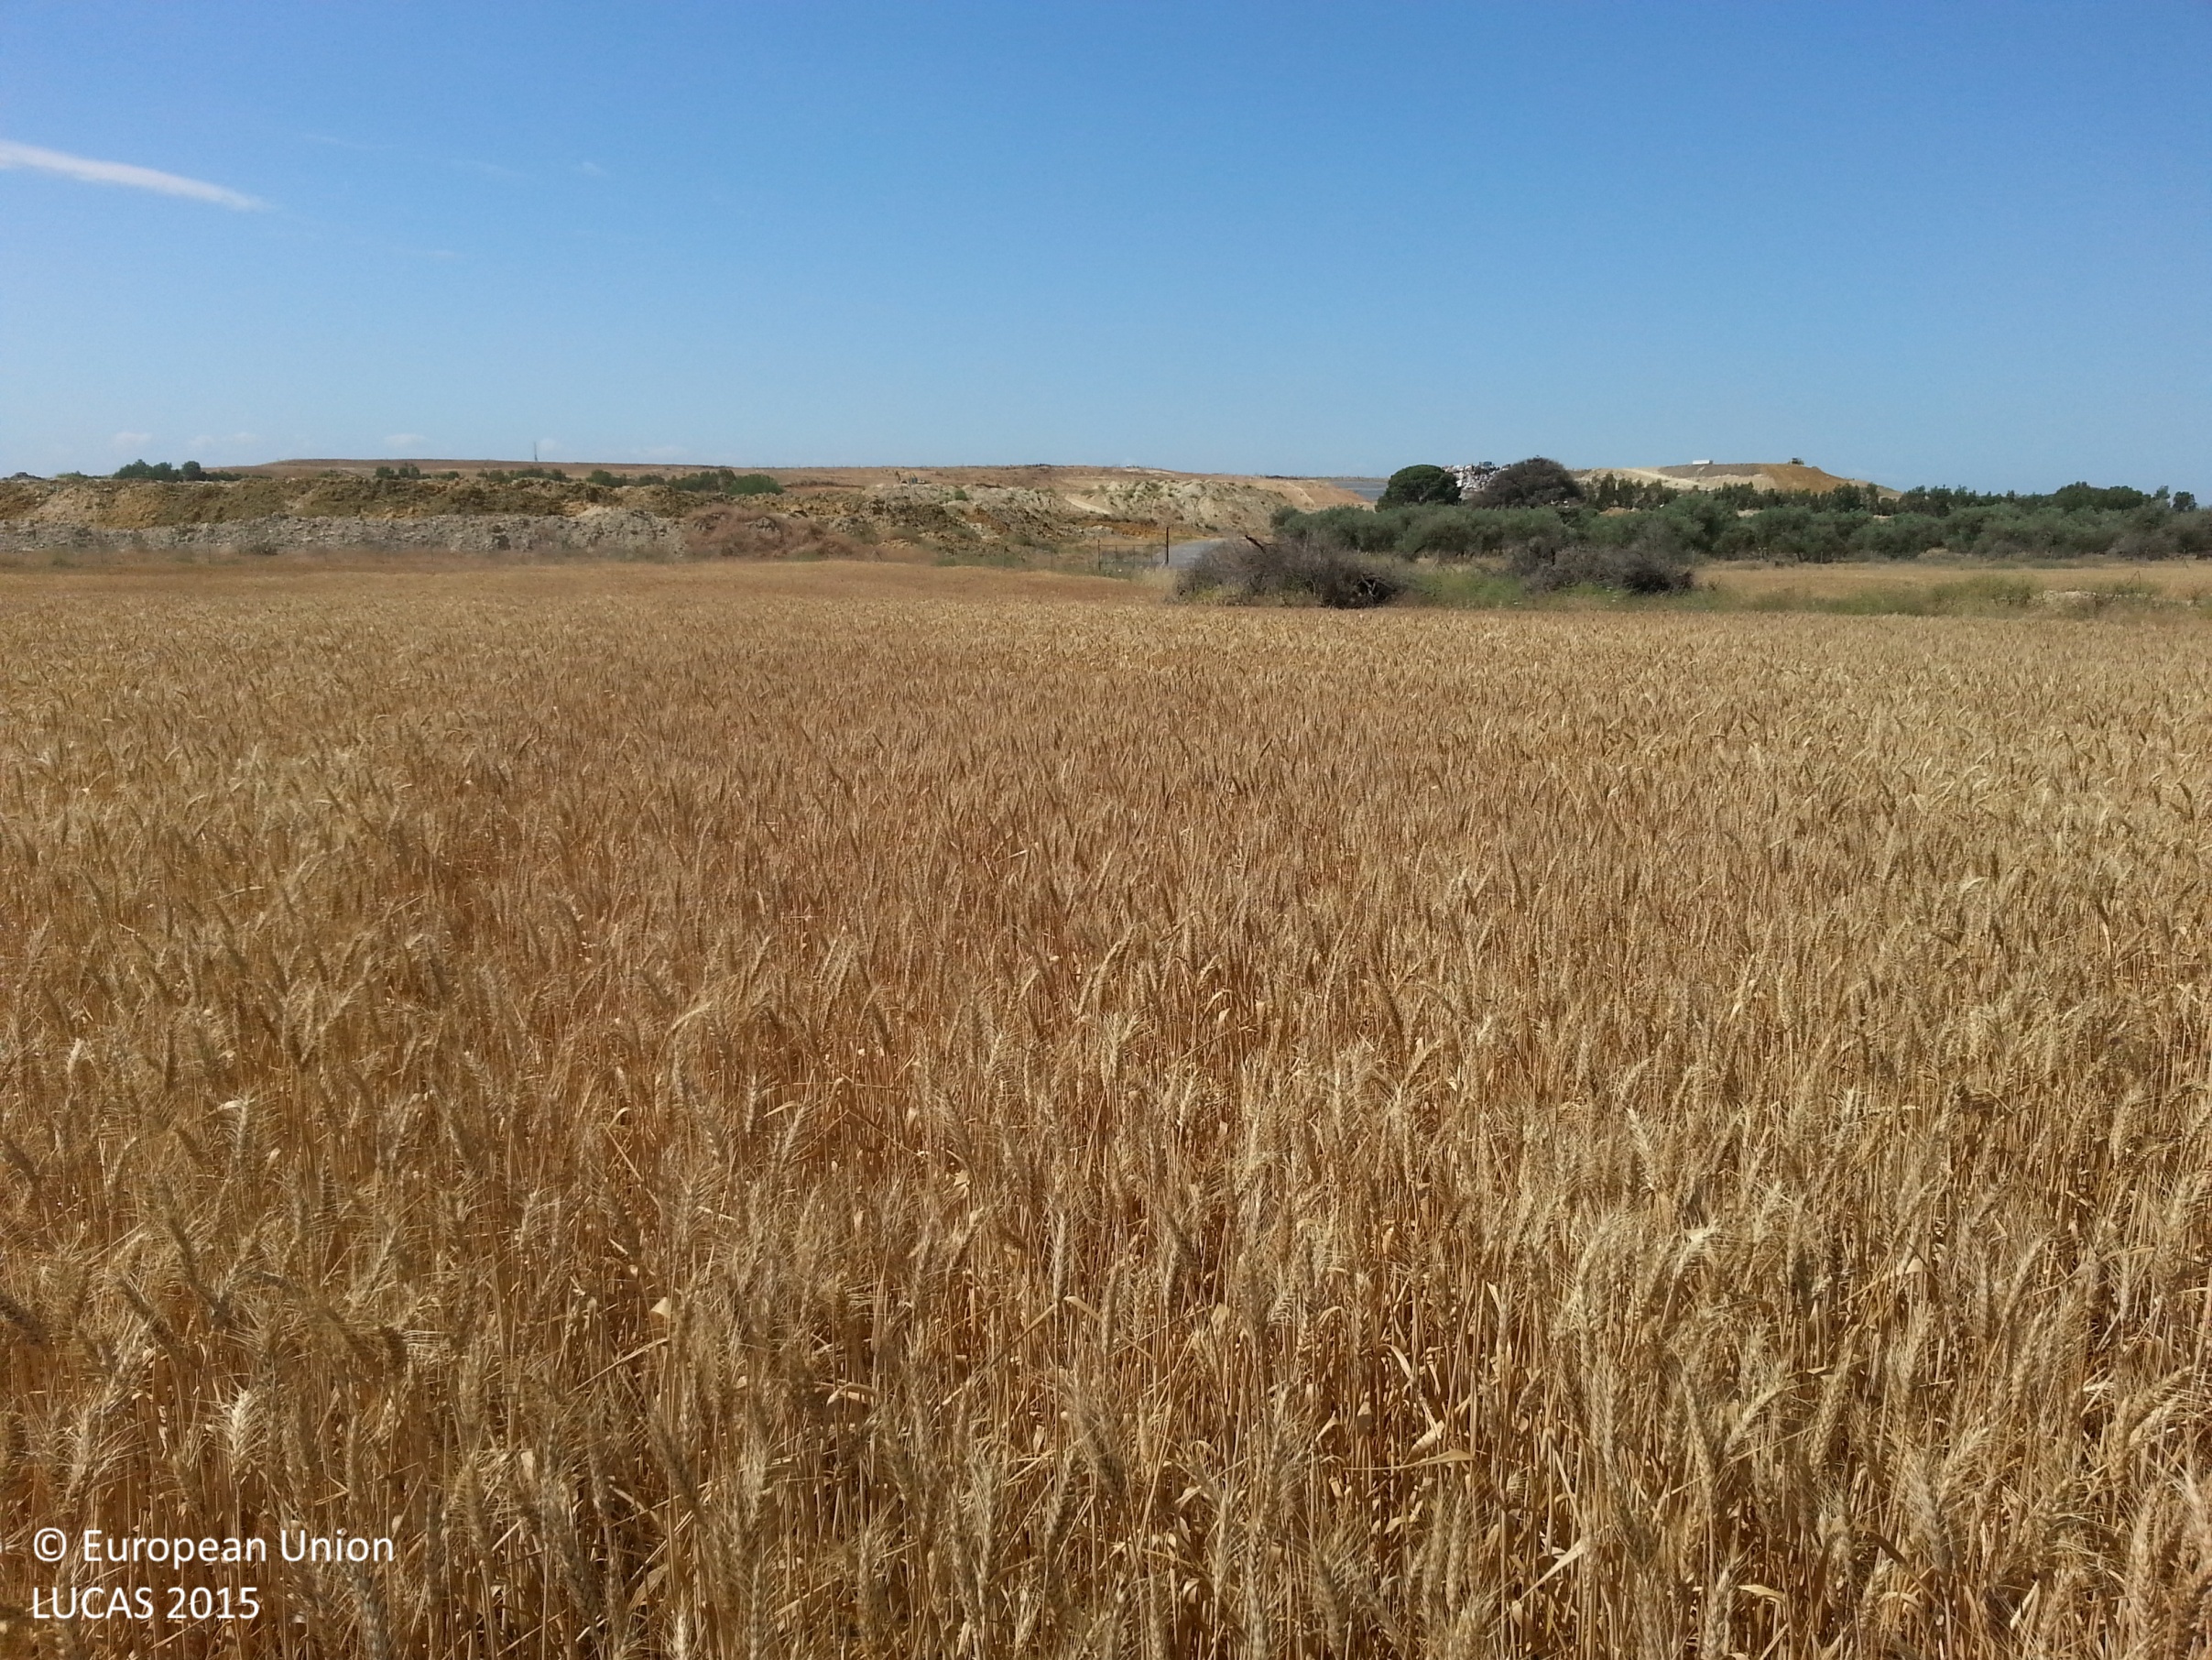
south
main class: Cropland
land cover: Durum wheat
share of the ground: > 75 %
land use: Agriculture (excluding fallow land and kitchen gardens)
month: May
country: ES
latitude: 37.2339
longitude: -5.8781
